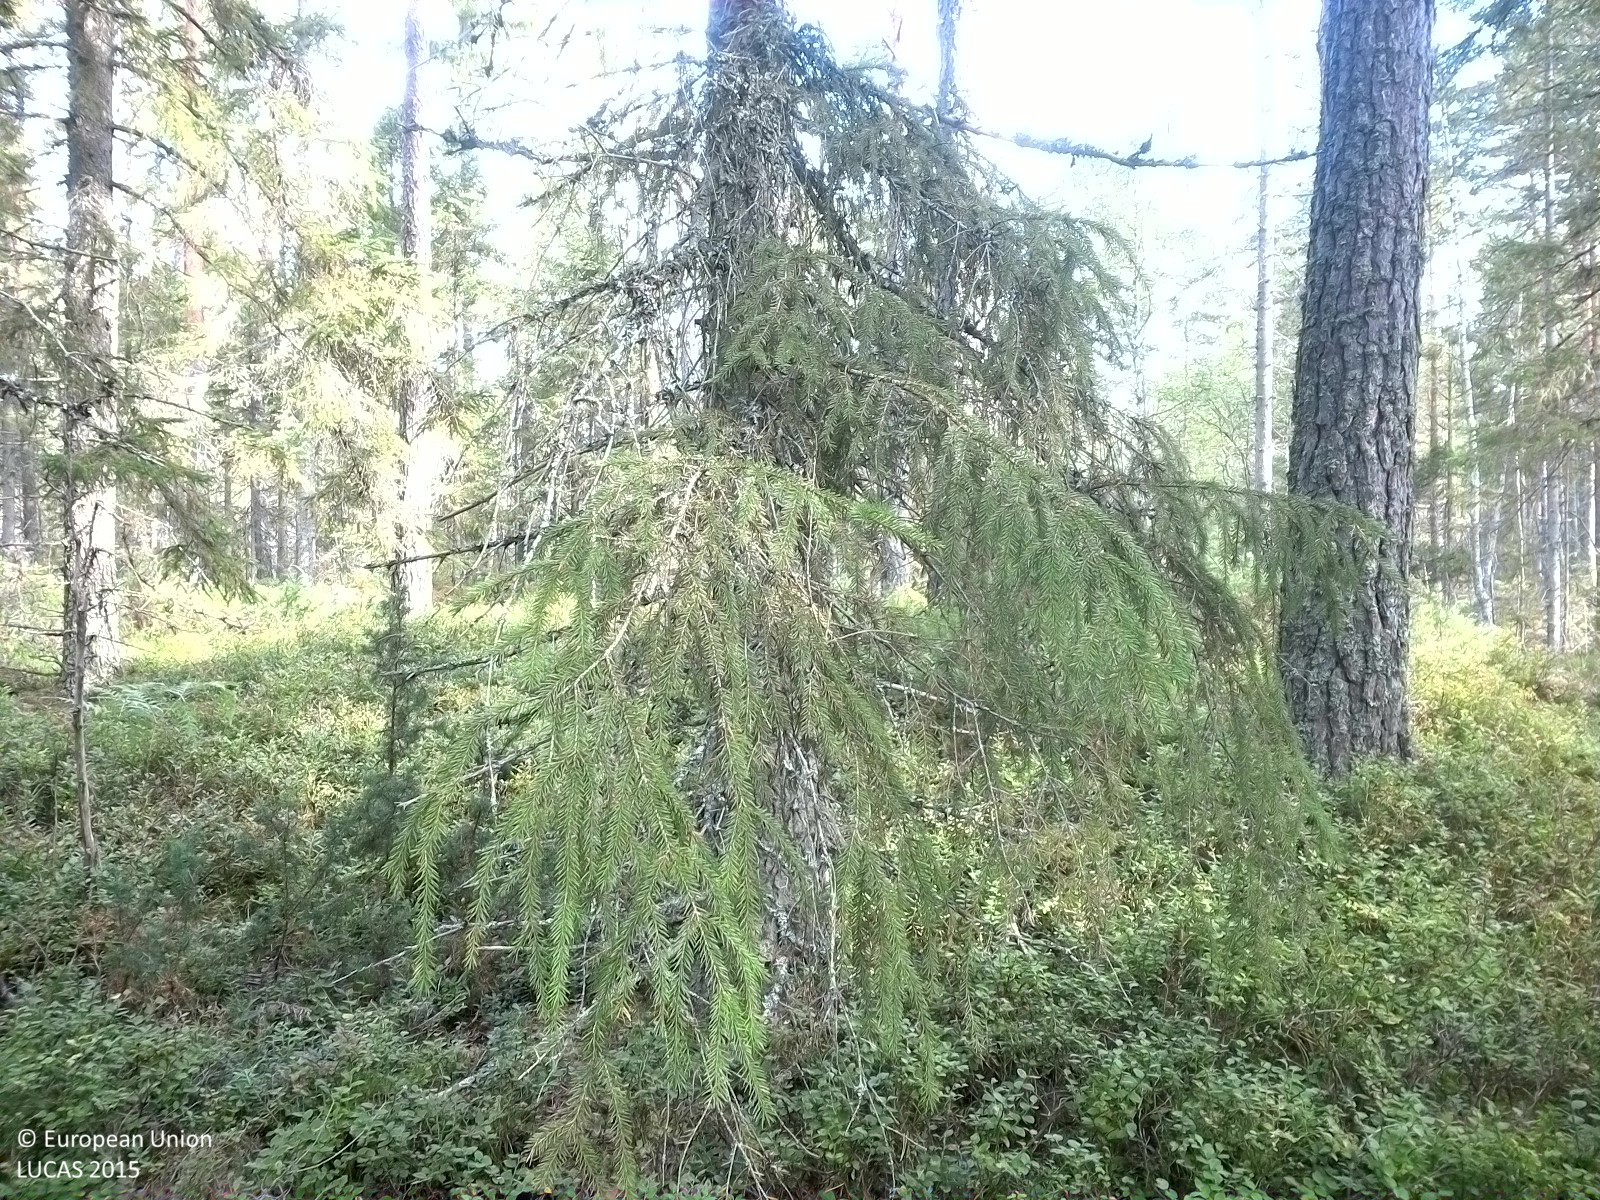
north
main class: Woodland
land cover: Pine dominated coniferous woodland
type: boreal forest
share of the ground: 25 - 50 %
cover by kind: coniferous forest trees 35 %, herbaceous plants 35 %, lichens and mosses 20 %, broadleaved forest trees 5 %, shrubs 5 %
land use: Forestry
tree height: > 5 m
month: August
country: SE
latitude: 58.8098
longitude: 15.5158
